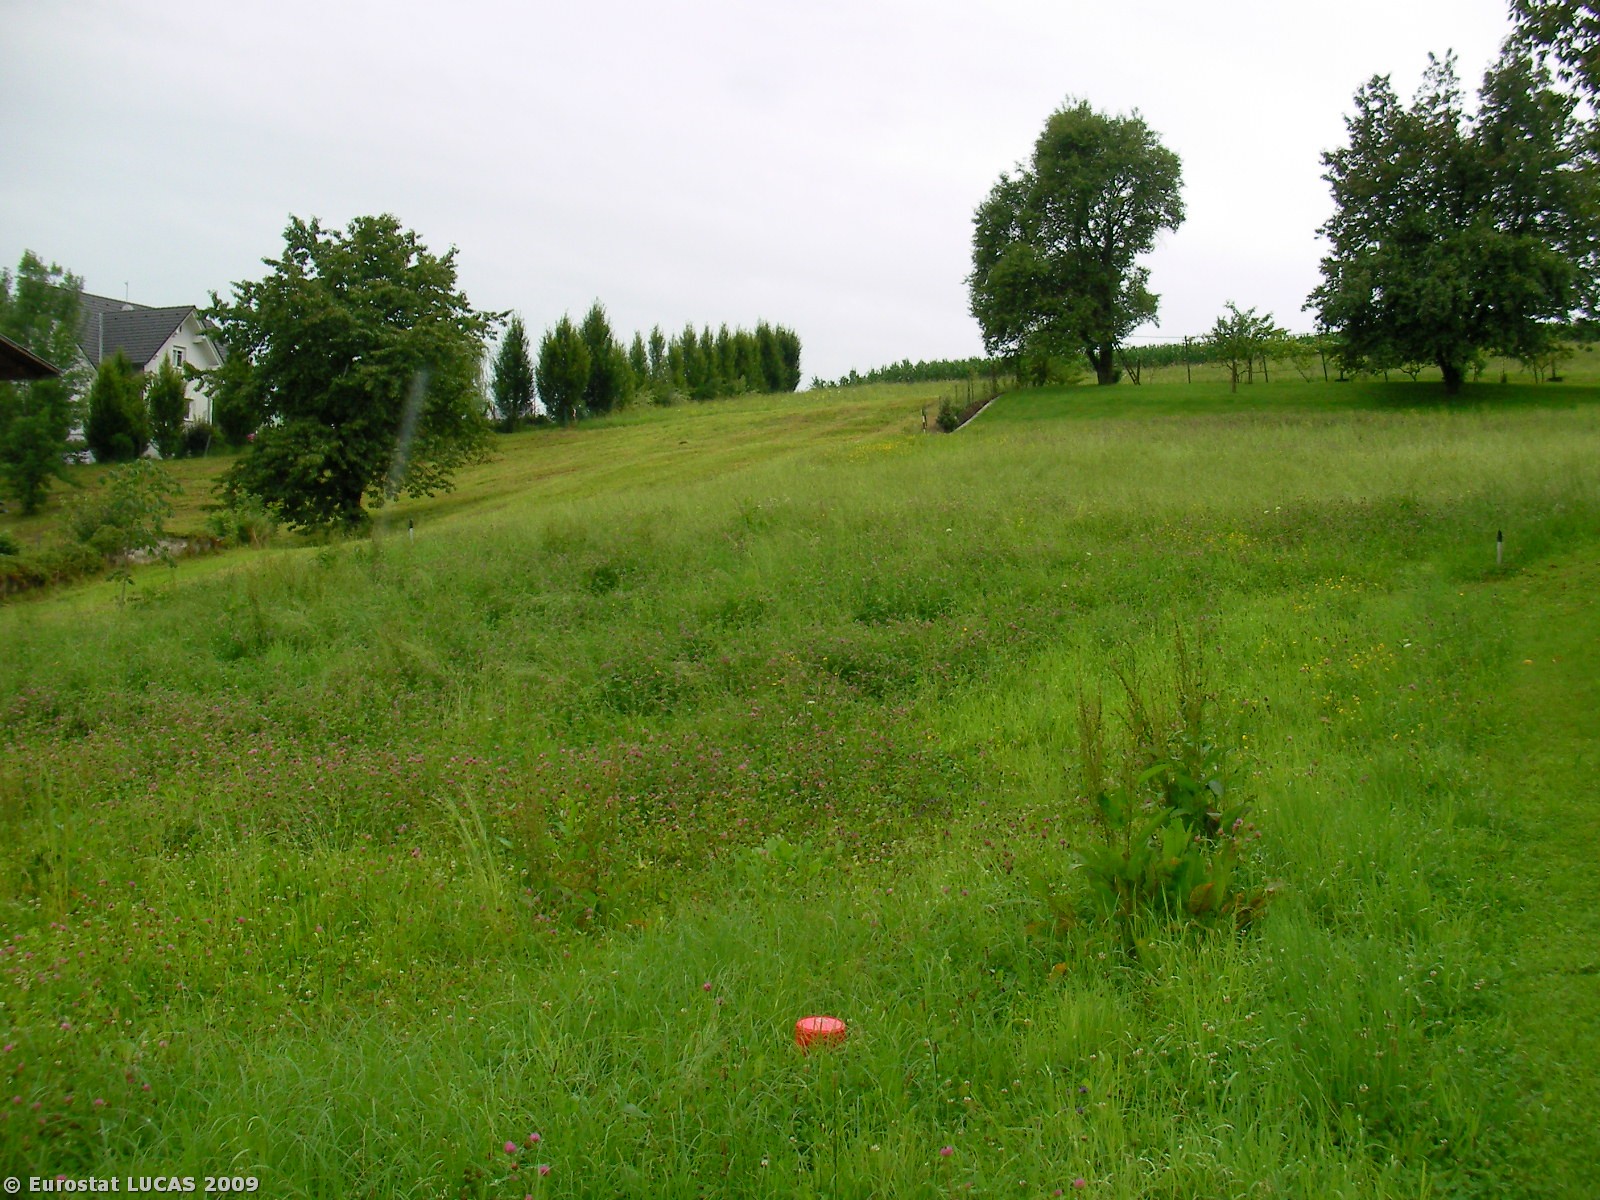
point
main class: Grassland
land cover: Grassland without tree/shrub cover
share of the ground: > 75 %
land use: Agriculture (excluding fallow land and kitchen gardens)
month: July
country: AT
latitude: 46.9027
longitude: 15.7105
